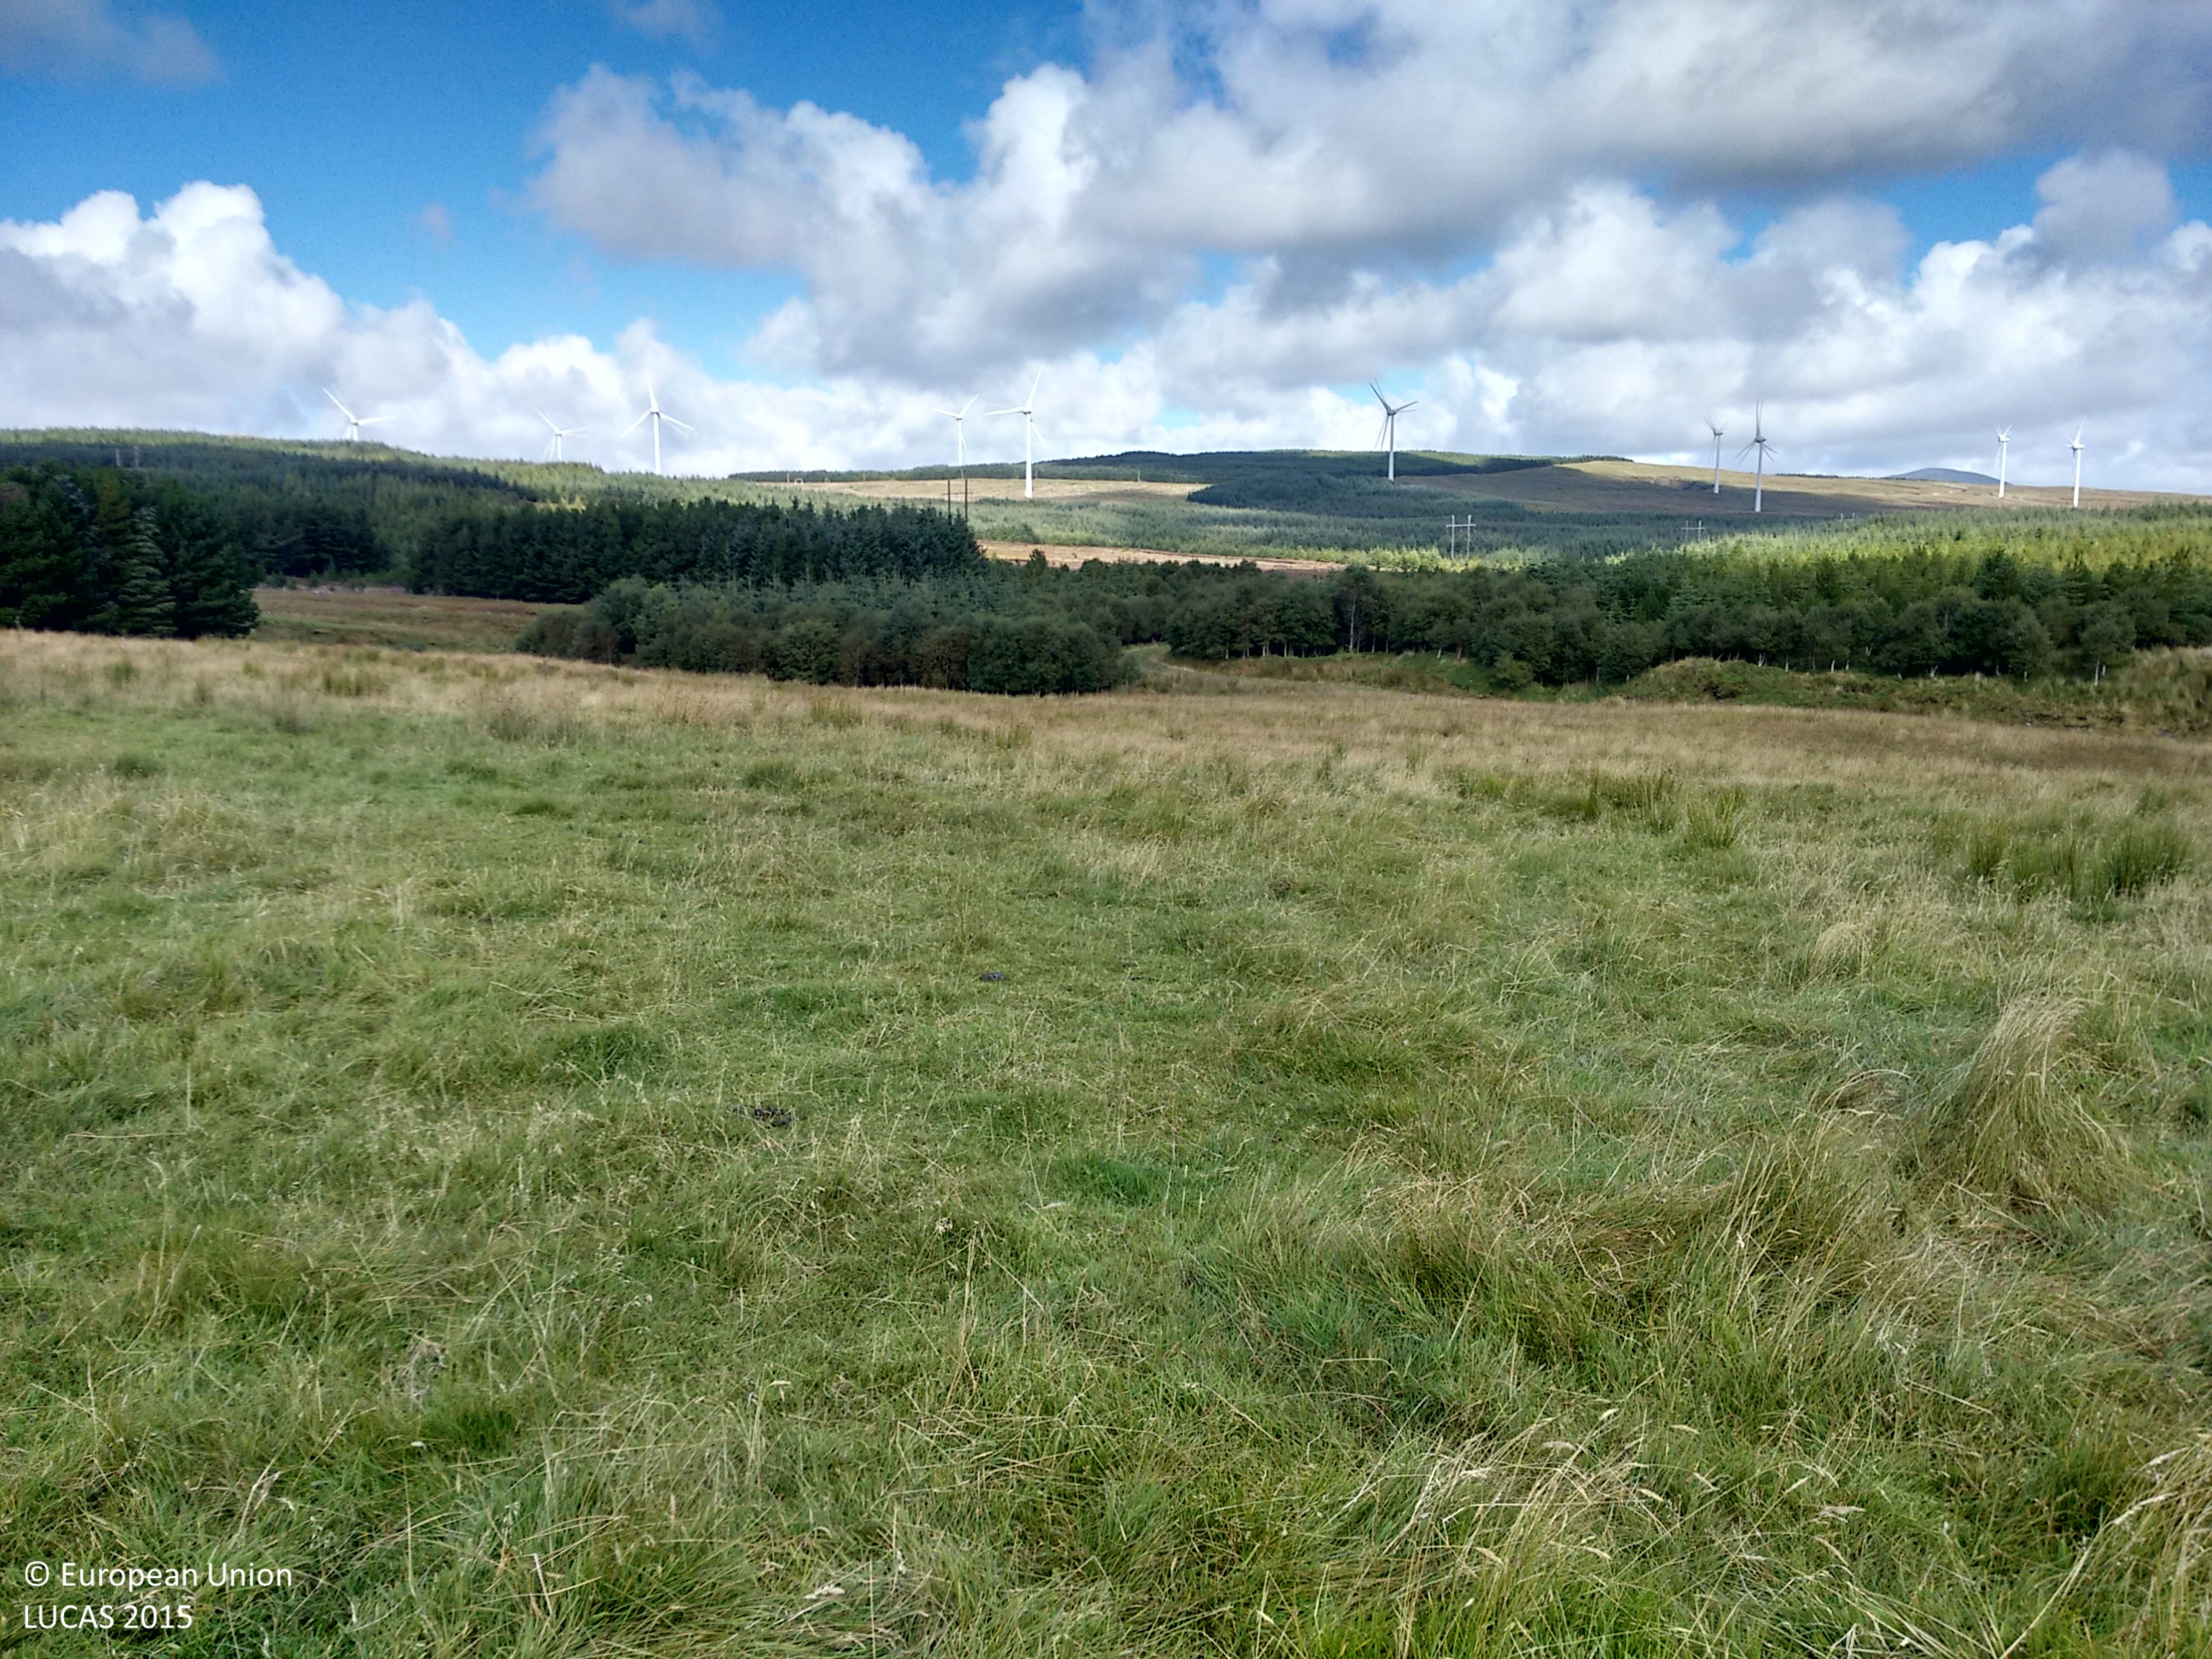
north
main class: Grassland
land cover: Grassland without tree/shrub cover
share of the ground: > 75 %
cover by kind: herbaceous plants 100 %
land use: Agriculture (excluding fallow land and kitchen gardens)
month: September
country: IE
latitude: 55.1165
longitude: -7.3803
